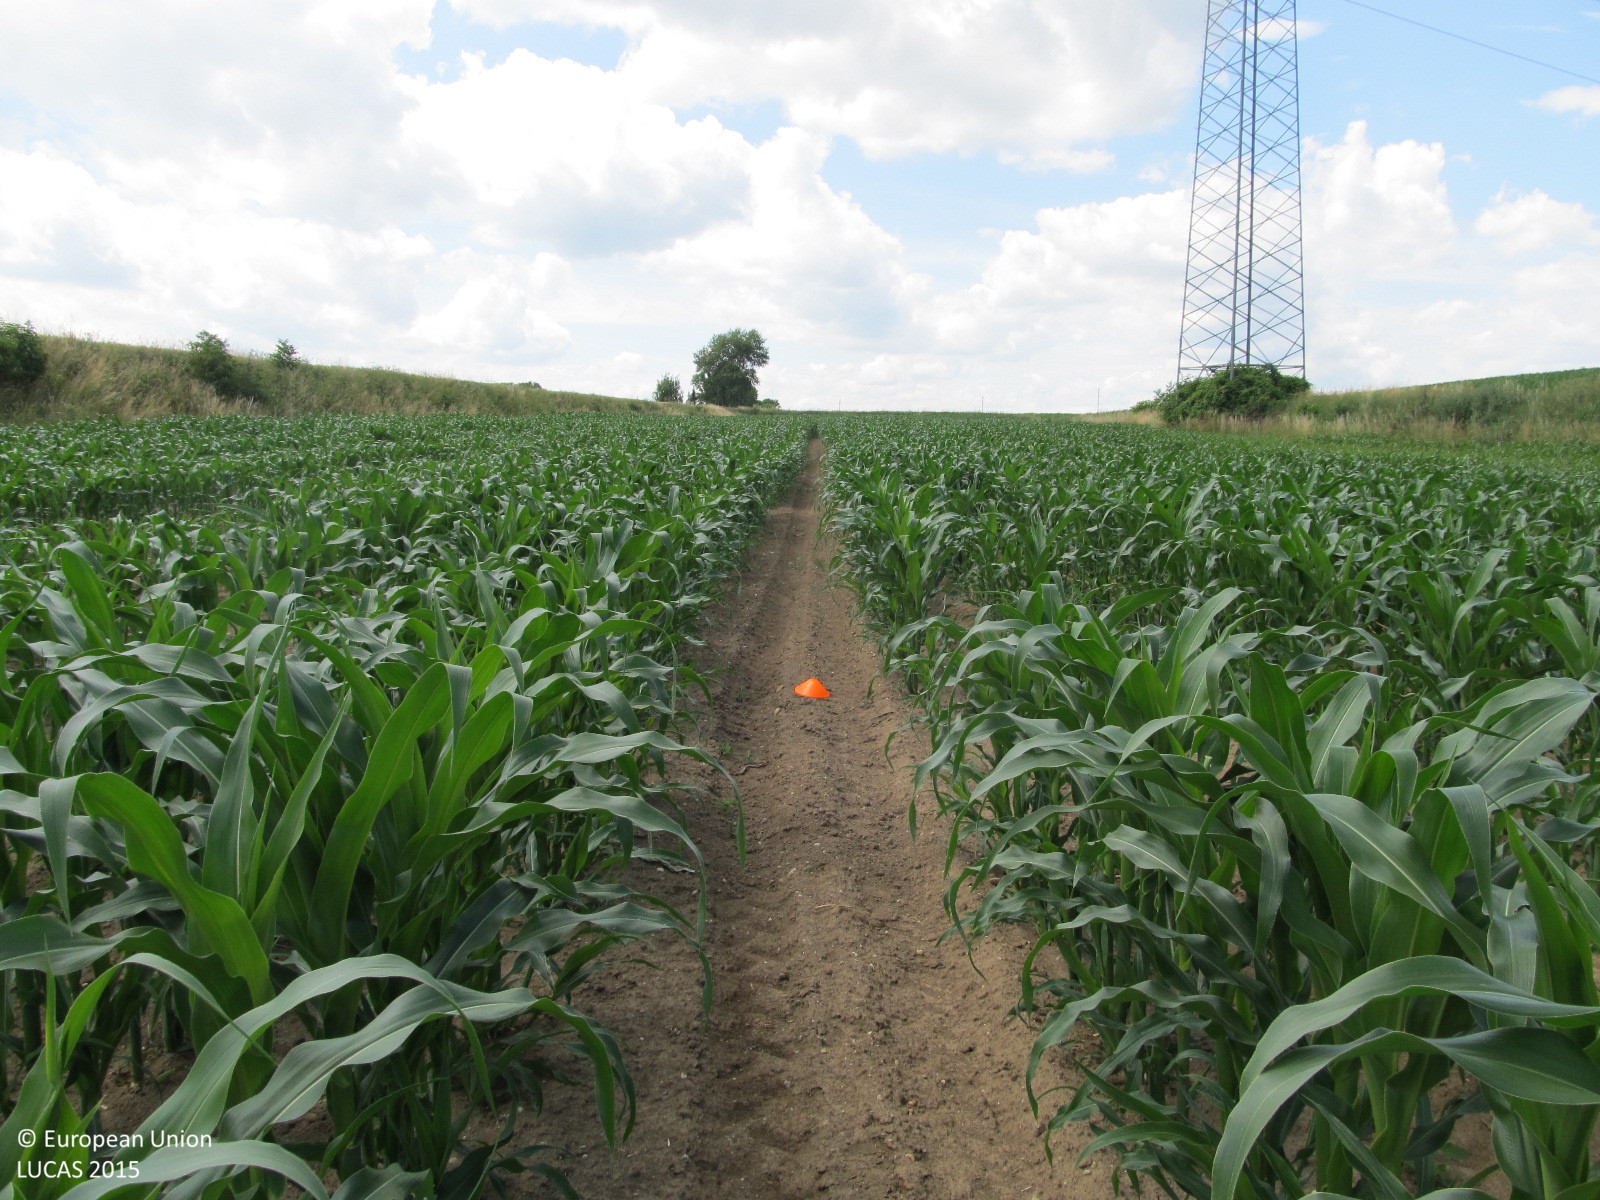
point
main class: Cropland
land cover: Maize
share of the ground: 50 - 75 %
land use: Agriculture (excluding fallow land and kitchen gardens)
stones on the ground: < 10 %
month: June
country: AT
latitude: 48.5184
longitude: 15.8660
